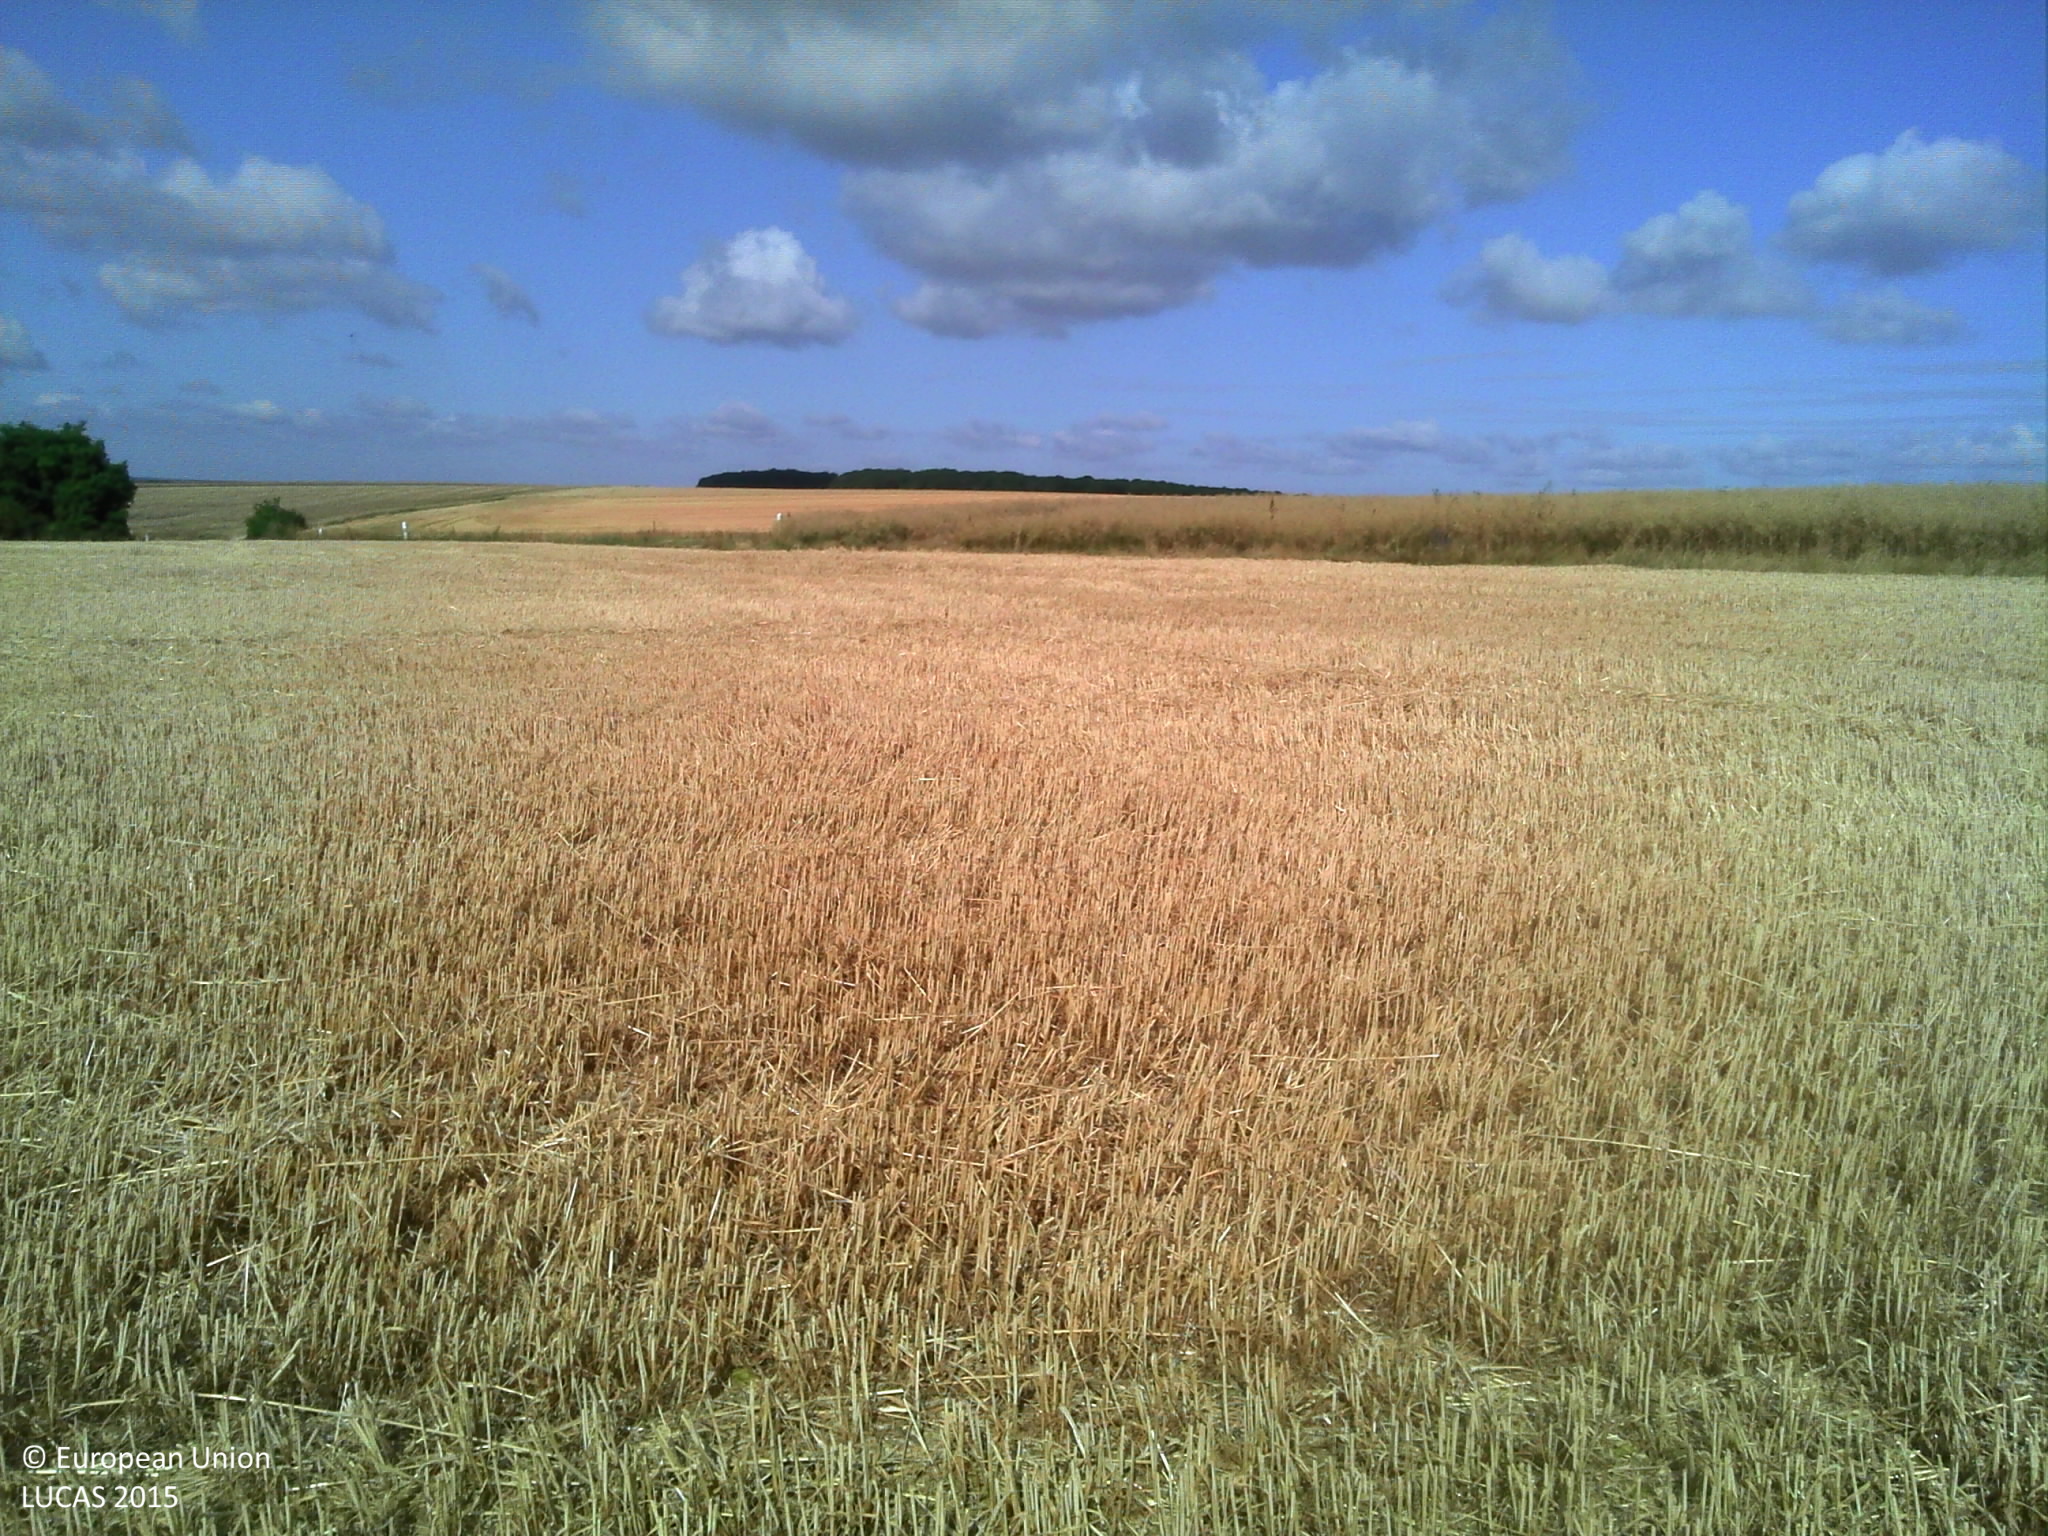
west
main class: Cropland
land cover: Common wheat
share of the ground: > 75 %
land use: Agriculture (excluding fallow land and kitchen gardens)
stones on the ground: 10 - 25 %
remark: Harvested field
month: July
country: FR
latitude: 48.2608
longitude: 3.4070
